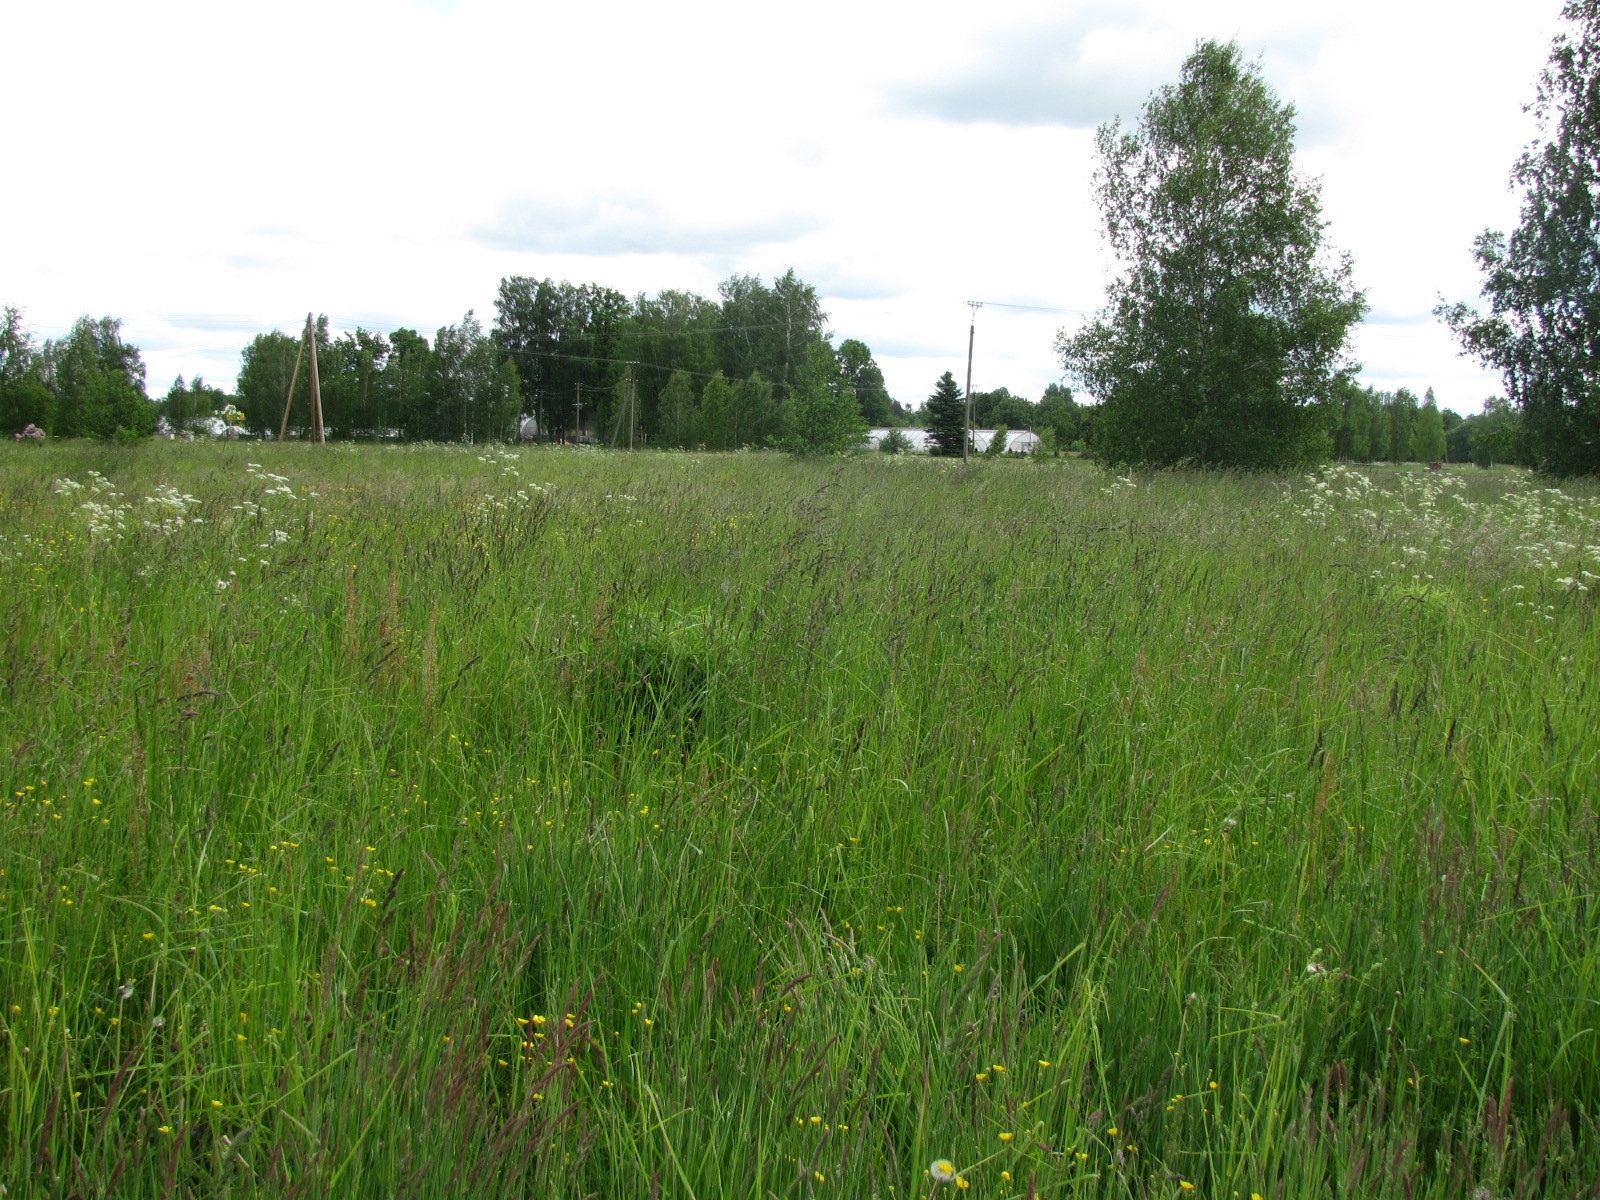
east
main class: Grassland
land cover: Grassland without tree/shrub cover
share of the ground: > 75 %
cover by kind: herbaceous plants 100 %
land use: Agriculture (excluding fallow land and kitchen gardens)
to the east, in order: Grassland without tree/shrub cover; Lines of trees; Ditches and canals; Grass margins; Paved roads, cycling and walking lanes; Grassland without tree/shrub cover; Shruby margins; Grassland without tree/shrub cover; Electric lines; Grassland without tree/shrub cover; Ditches and canals; Grassland without tree/shrub cover; Paved roads, cycling and walking lanes; Grassland without tree/shrub cover; Electric lines; Oats; Potatoes; Grassland without tree/shrub cover; Ditches and canals; Lines of trees; Electric lines; Grassland without tree/shrub cover; Broadleaved woodland; Inland fresh water bodies
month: June
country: LV
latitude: 56.6757
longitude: 23.8396
